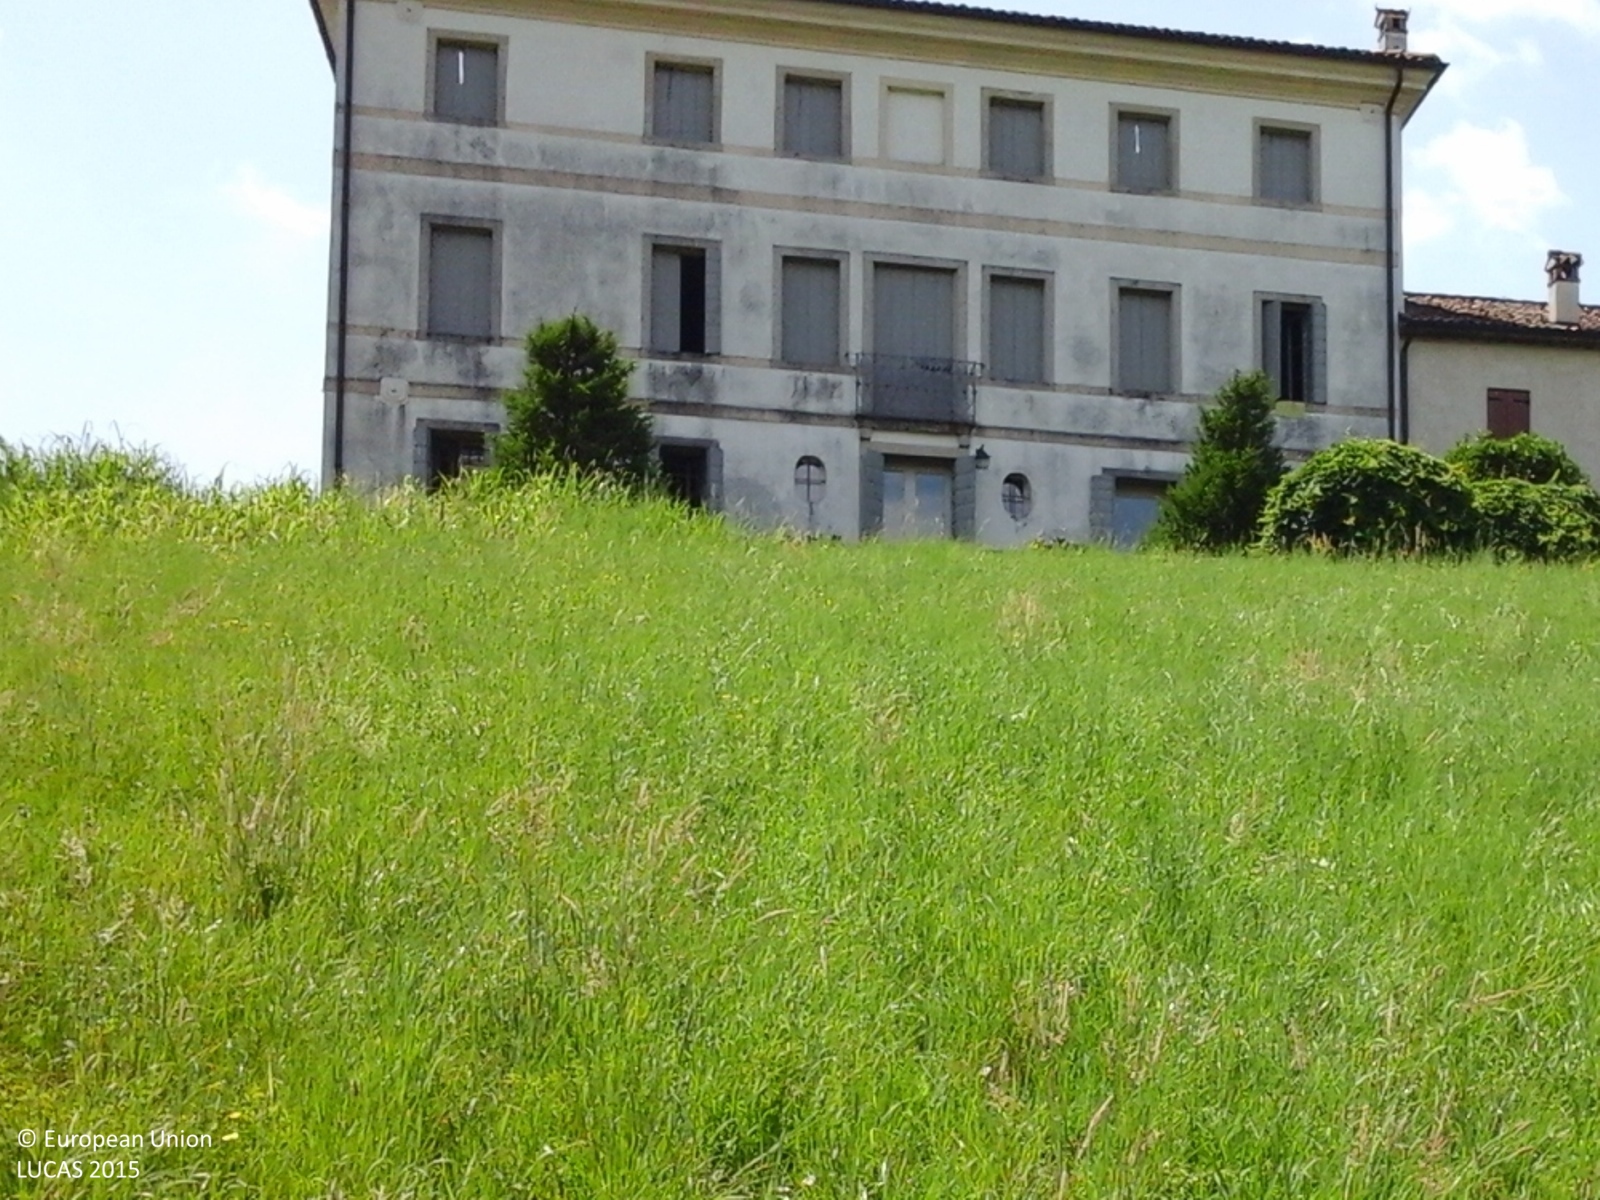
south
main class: Grassland
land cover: Grassland without tree/shrub cover
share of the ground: > 75 %
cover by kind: herbaceous plants 100 %
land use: Agriculture (excluding fallow land and kitchen gardens)
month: June
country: IT
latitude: 45.9293
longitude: 12.3310
